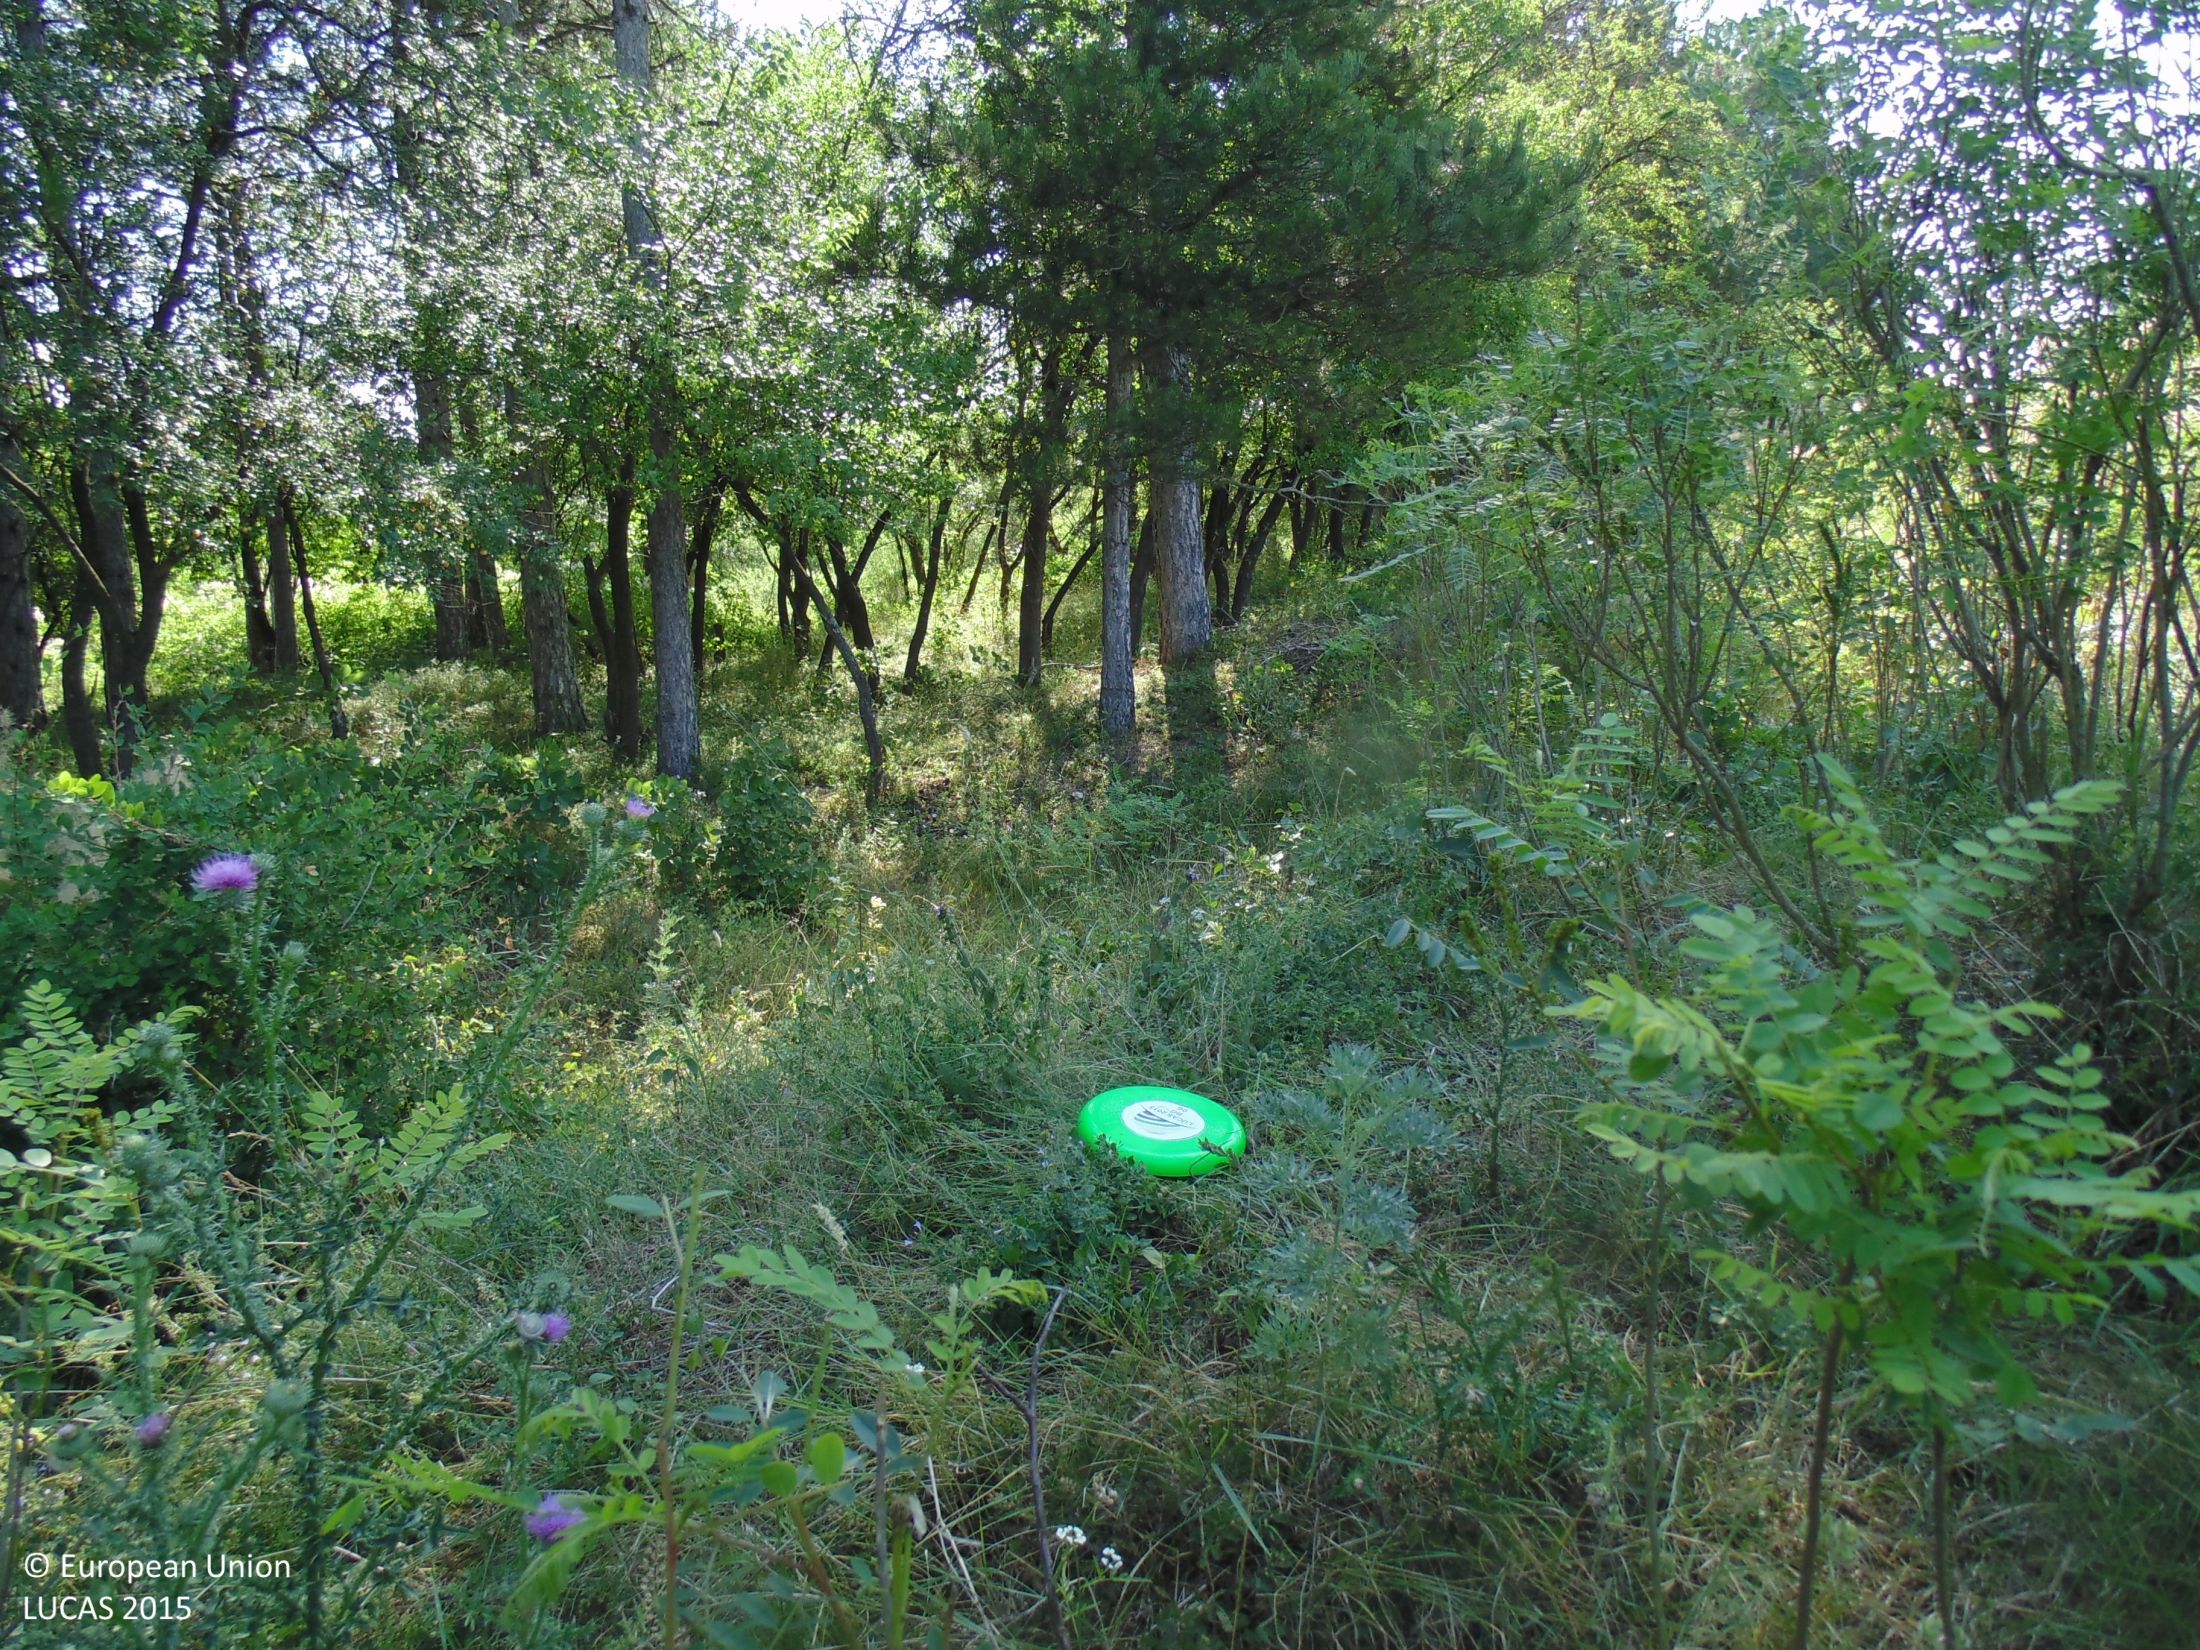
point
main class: Grassland
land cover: Grassland with sparse tree/shrub cover
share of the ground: > 75 %
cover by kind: herbaceous plants 85 %, shrubs 10 %, broadleaved forest trees 5 %
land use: Agriculture (excluding fallow land and kitchen gardens)
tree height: < 5 m
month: July
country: BG
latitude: 43.5515
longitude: 27.8038
